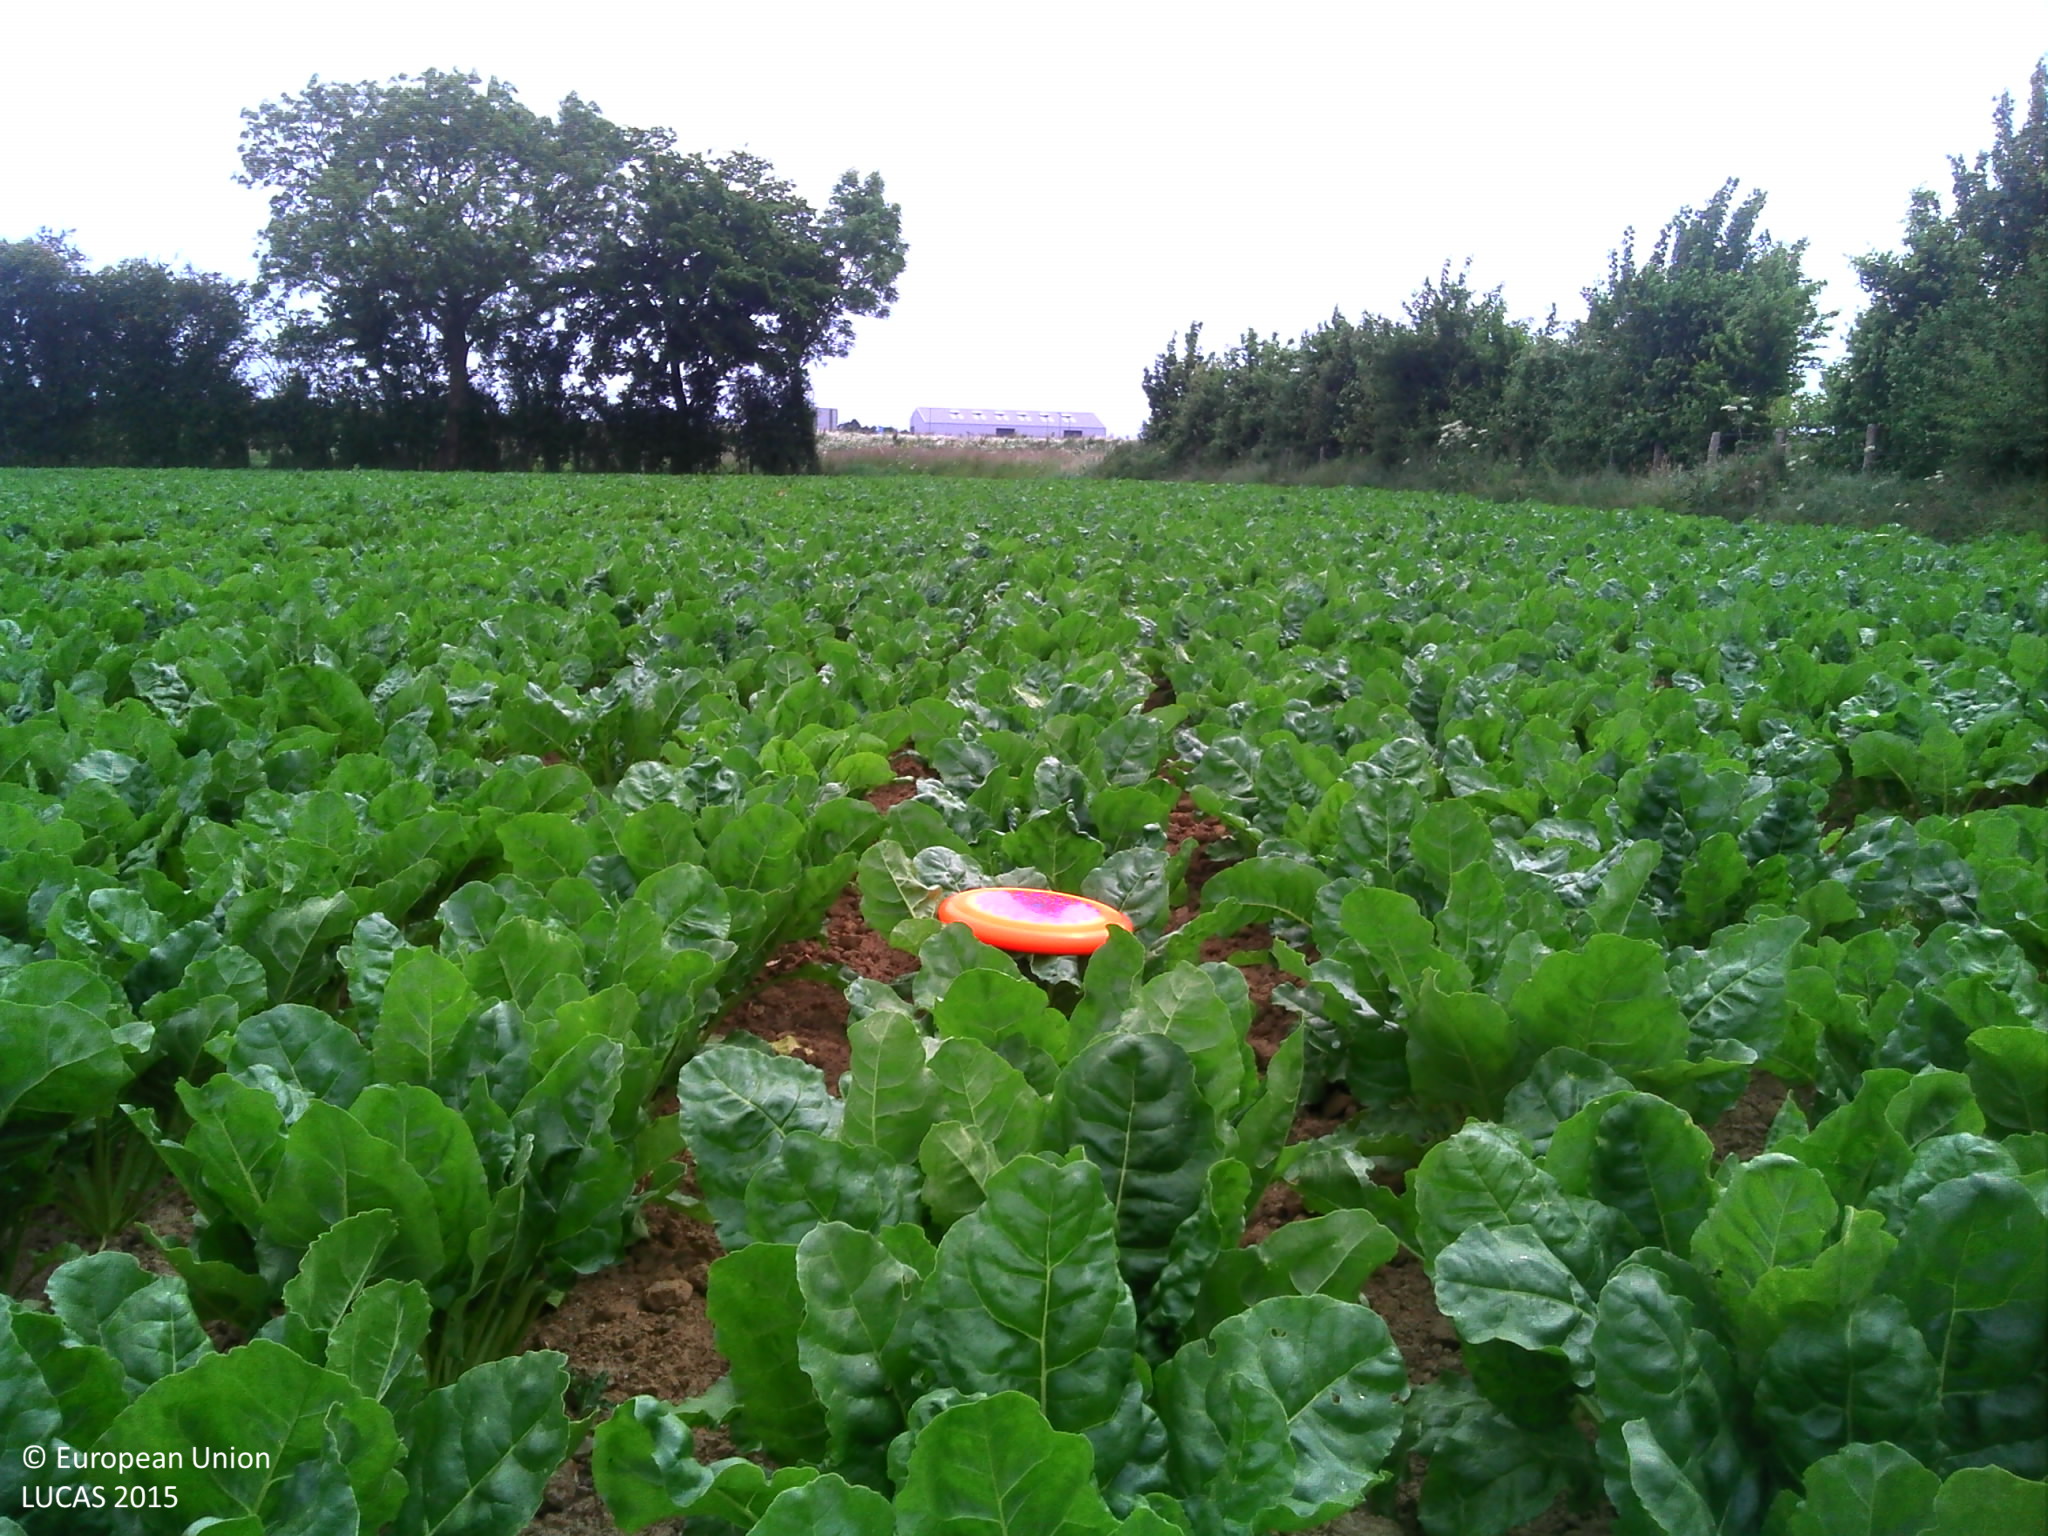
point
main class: Cropland
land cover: Sugar beet
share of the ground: > 75 %
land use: Agriculture (excluding fallow land and kitchen gardens)
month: June
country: FR
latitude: 48.6366
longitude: 0.1878
